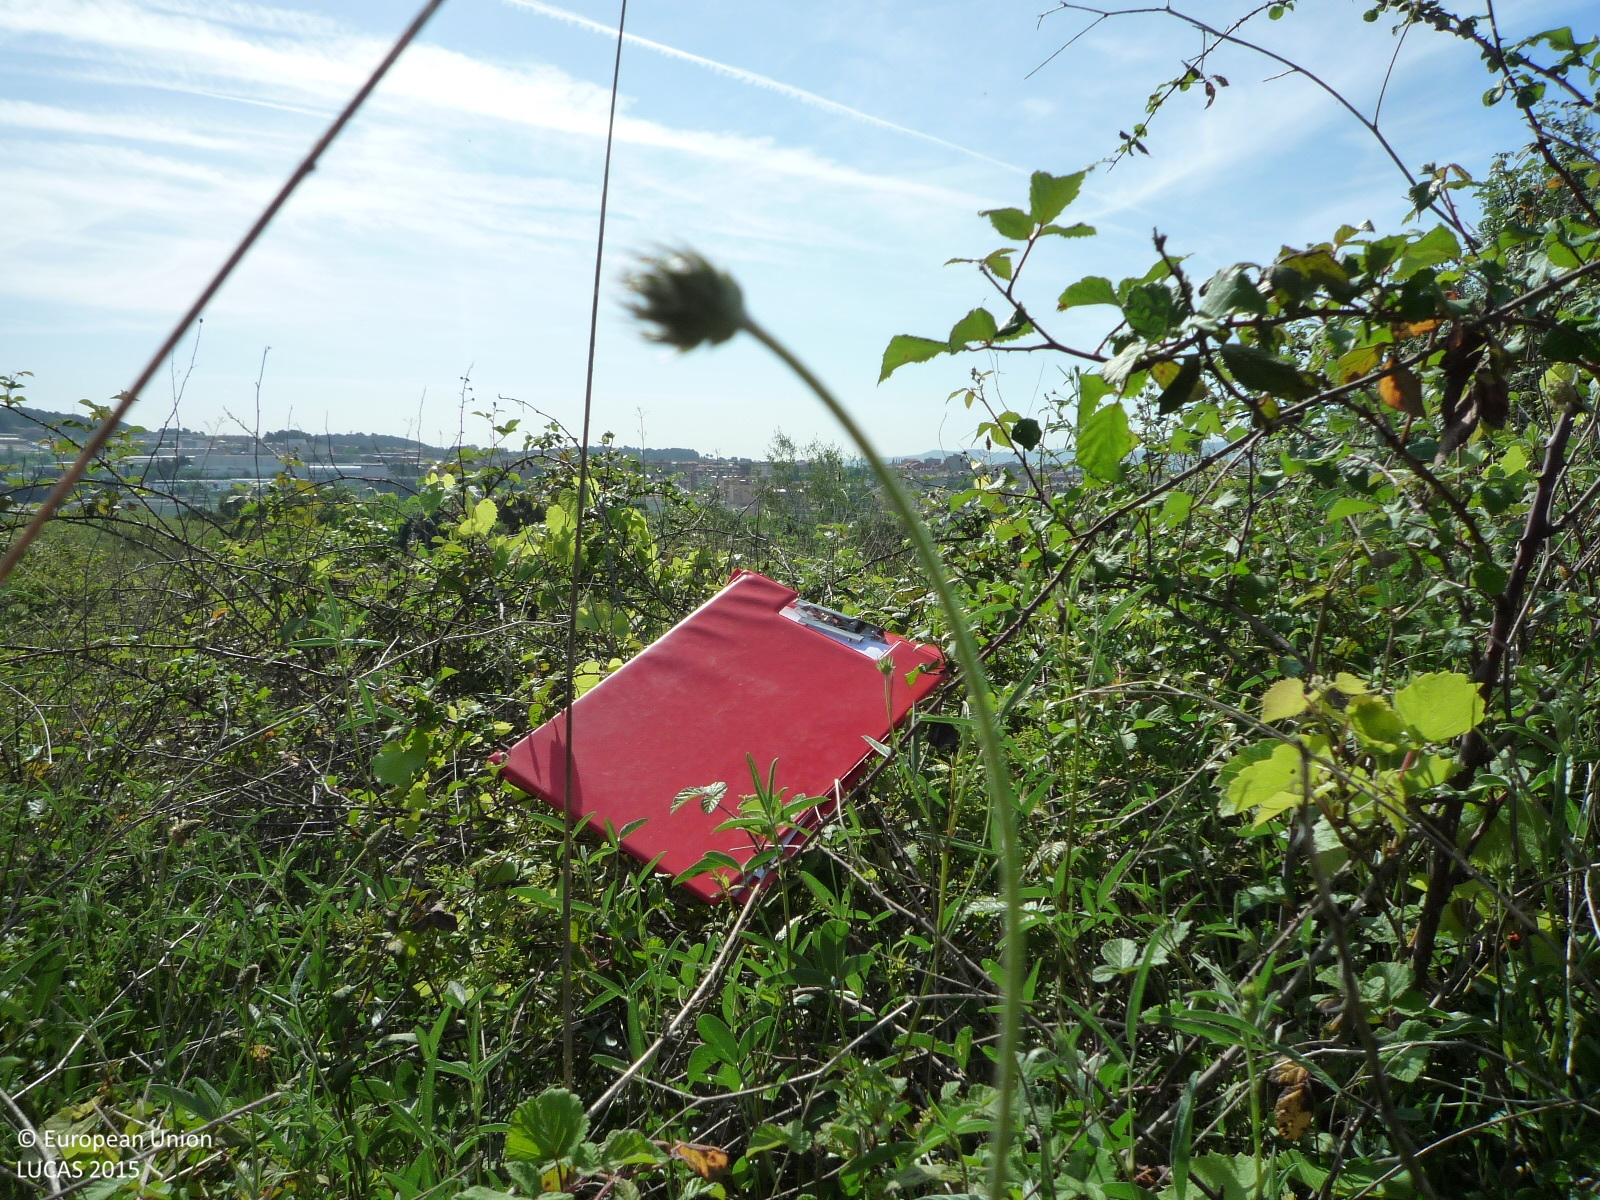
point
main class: Shrubland
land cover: Shrubland with sparse tree cover
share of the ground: > 75 %
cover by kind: shrubs 85 %, herbaceous plants 10 %, broadleaved forest trees 5 %
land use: Abandoned areas
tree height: < 5 m
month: May
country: ES
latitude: 41.5046
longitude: 2.0262
